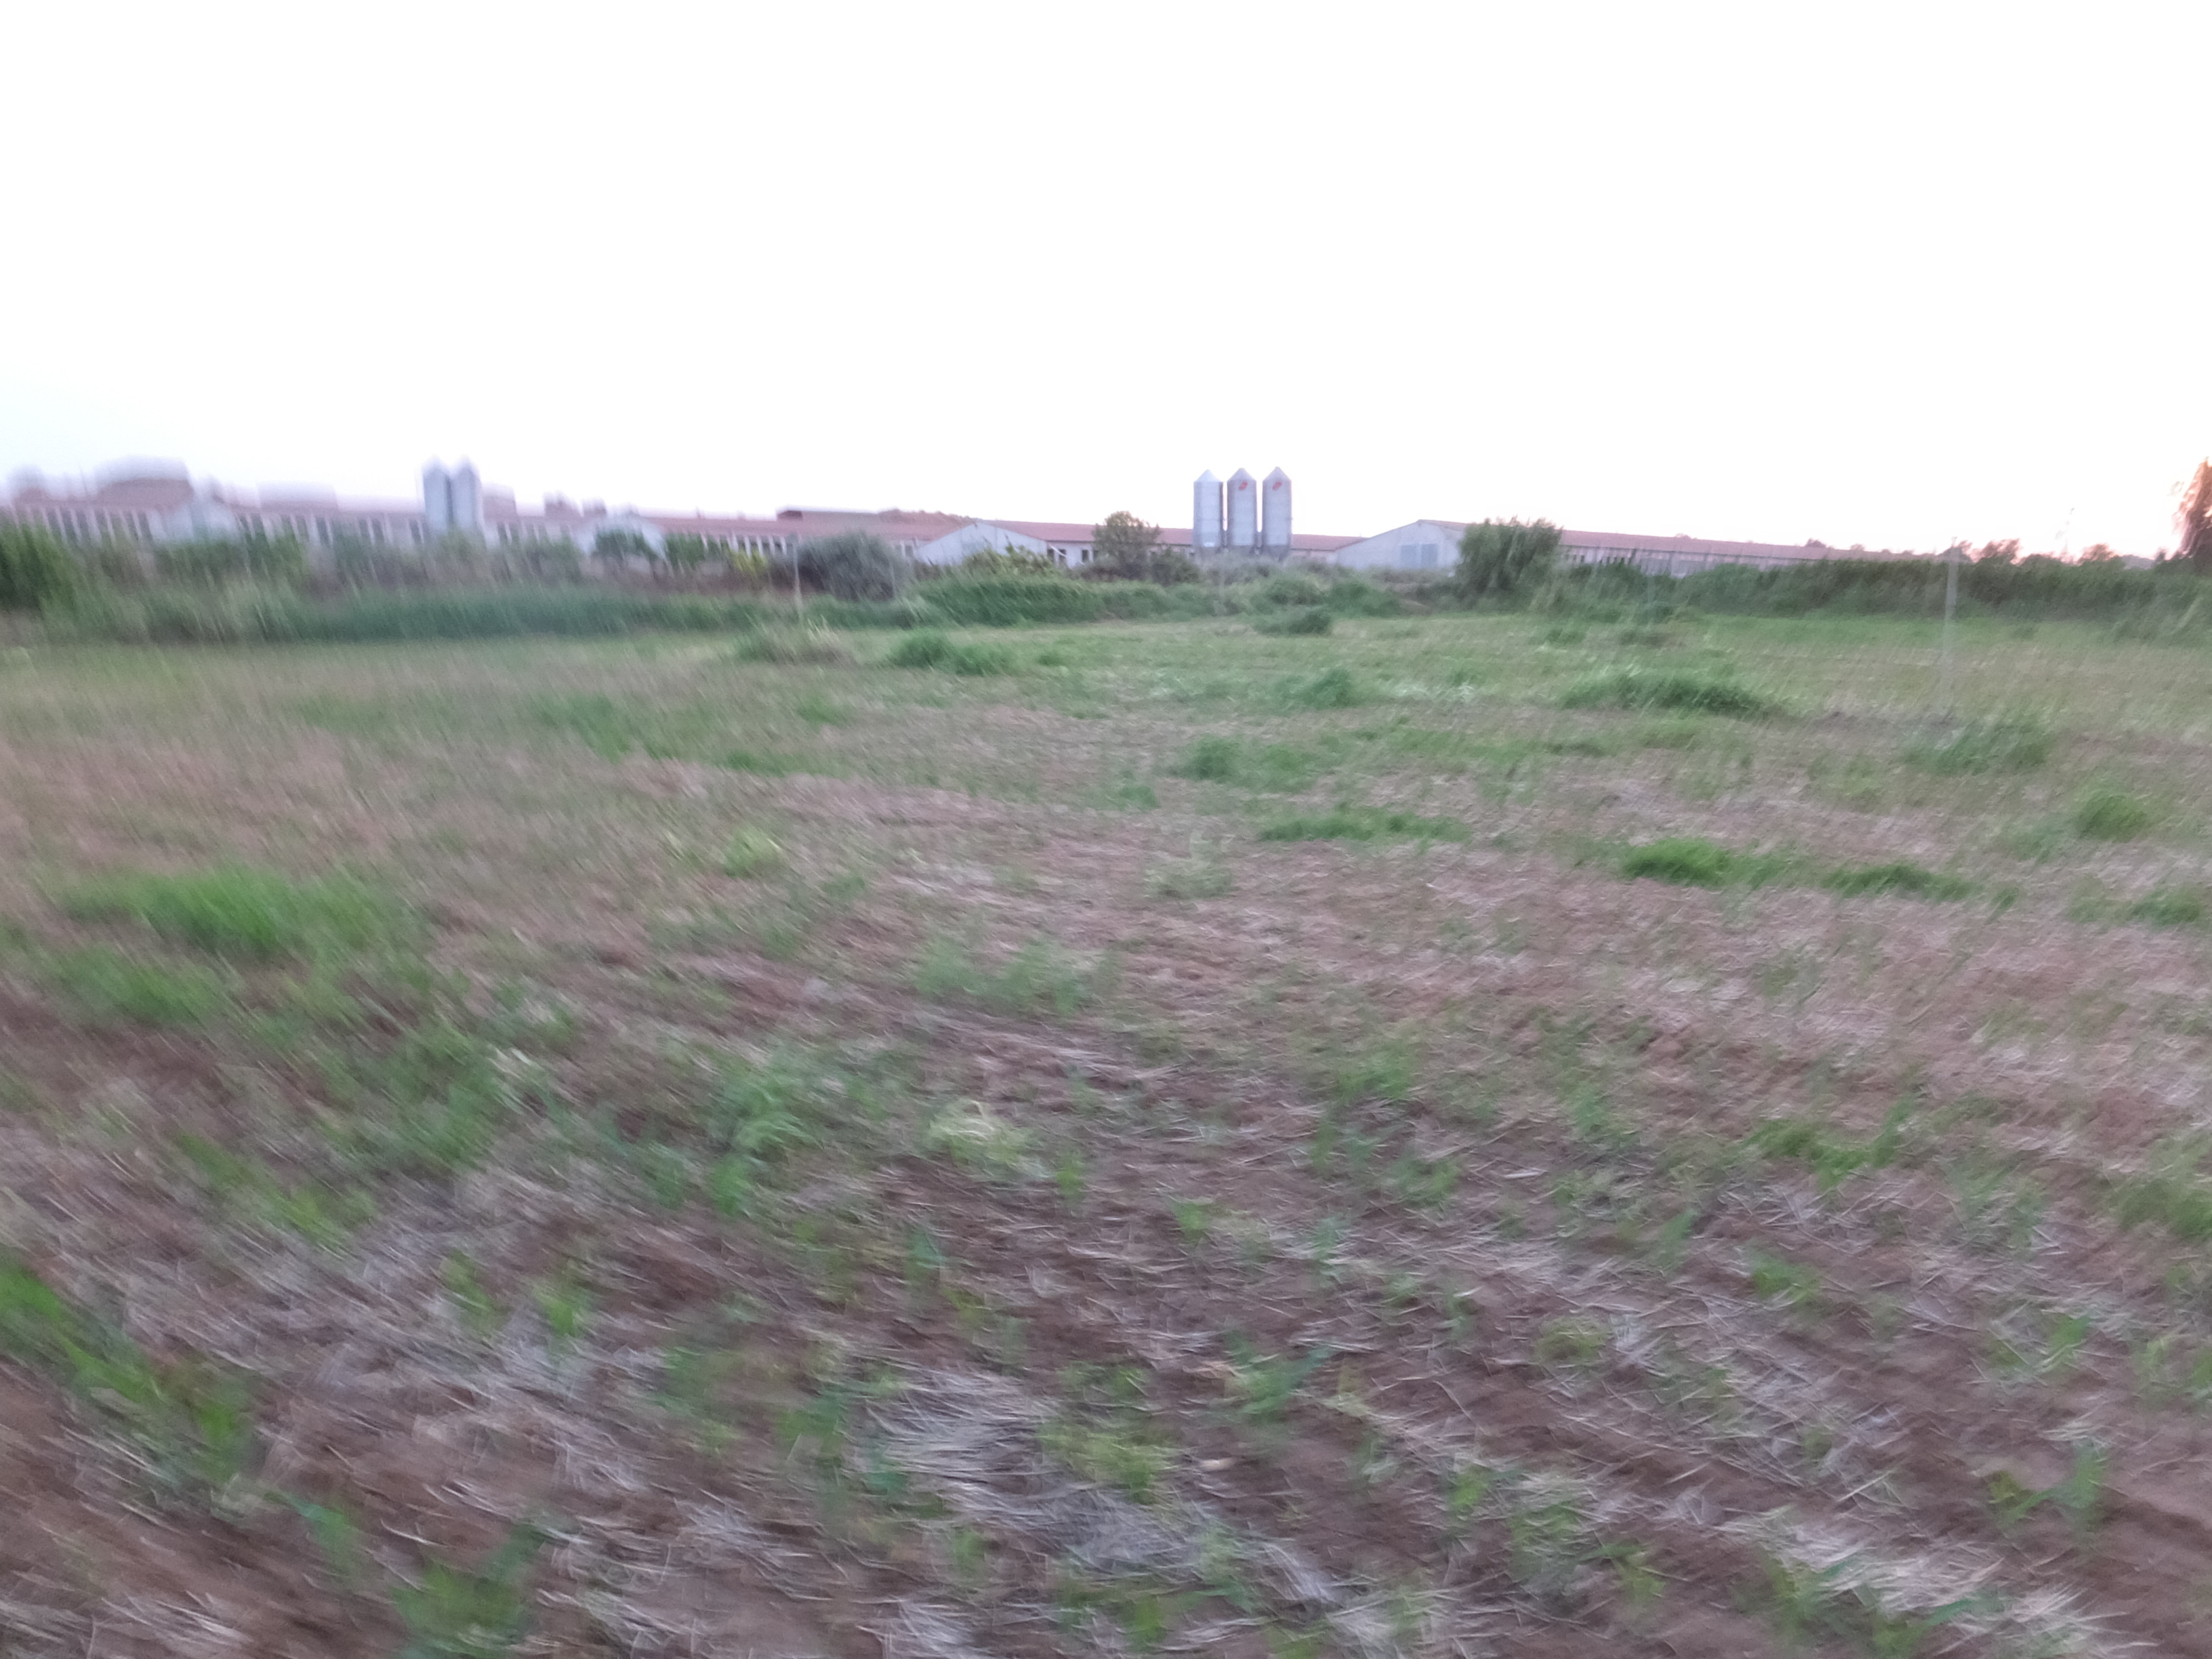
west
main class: Cropland
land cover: Maize
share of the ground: > 75 %
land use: Agriculture (excluding fallow land and kitchen gardens)
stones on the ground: < 10 %
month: July
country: ES
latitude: 41.7873
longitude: 0.2983
